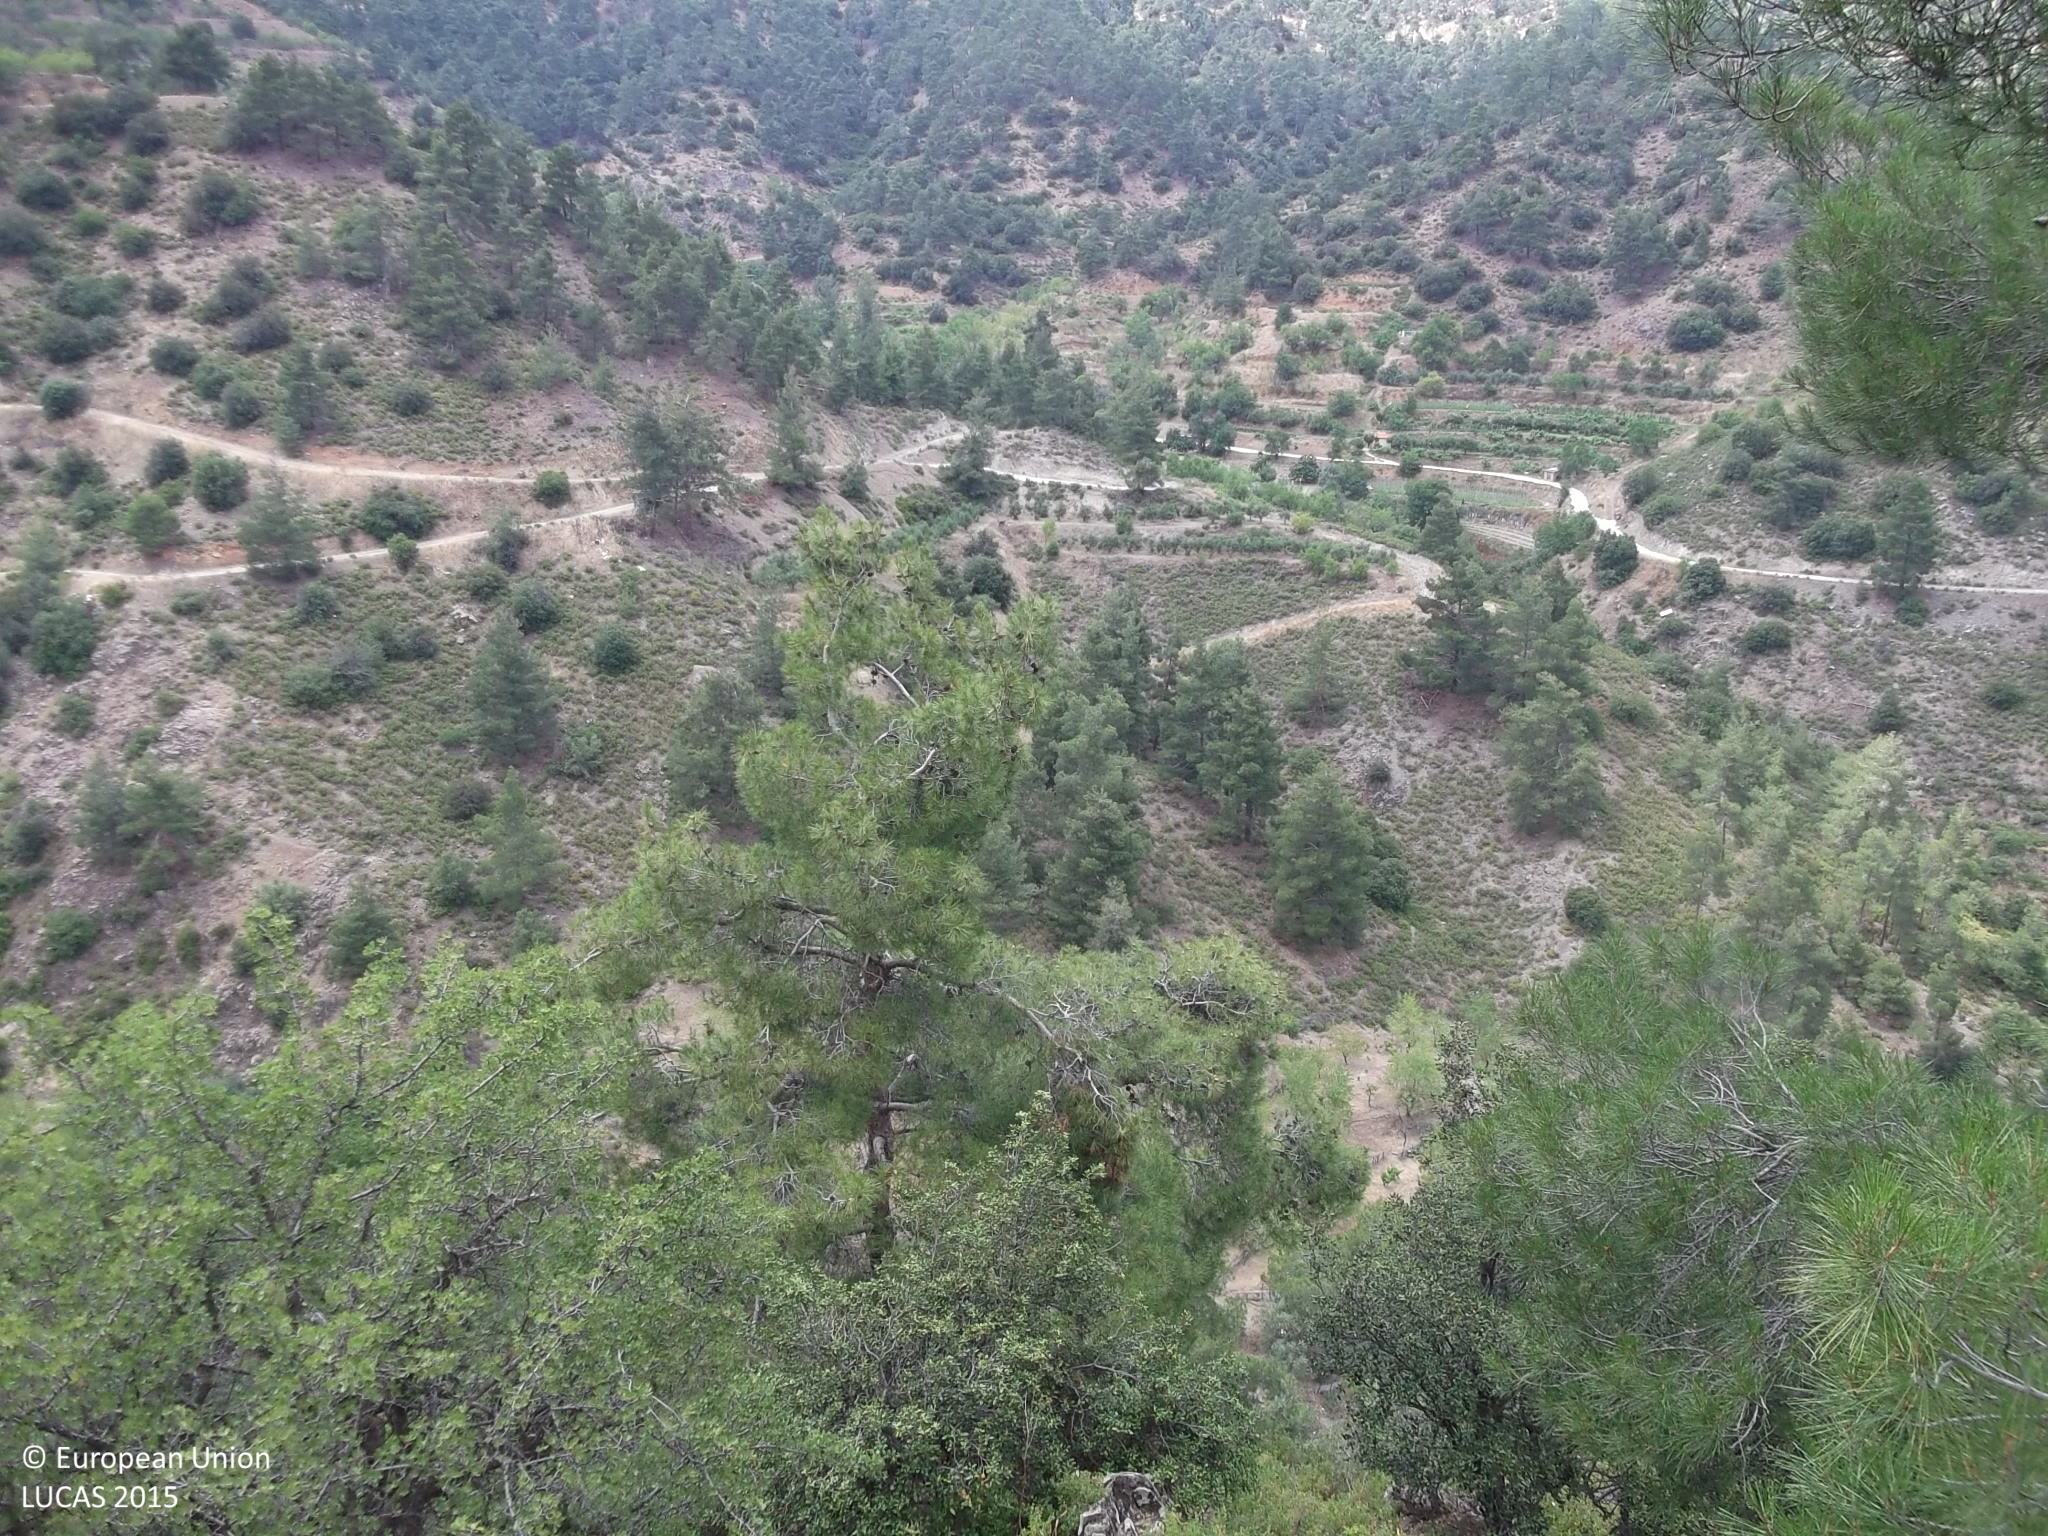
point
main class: Woodland
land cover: Pine dominated coniferous woodland
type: coniferous forest of the mediterranean region
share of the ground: 10 - 25 %
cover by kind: shrubs 55 %, unconsolidated bare surface 25 %, coniferous forest trees 20 %
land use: Forestry
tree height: > 5 m
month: June
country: CY
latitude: 34.9891
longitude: 32.9703
